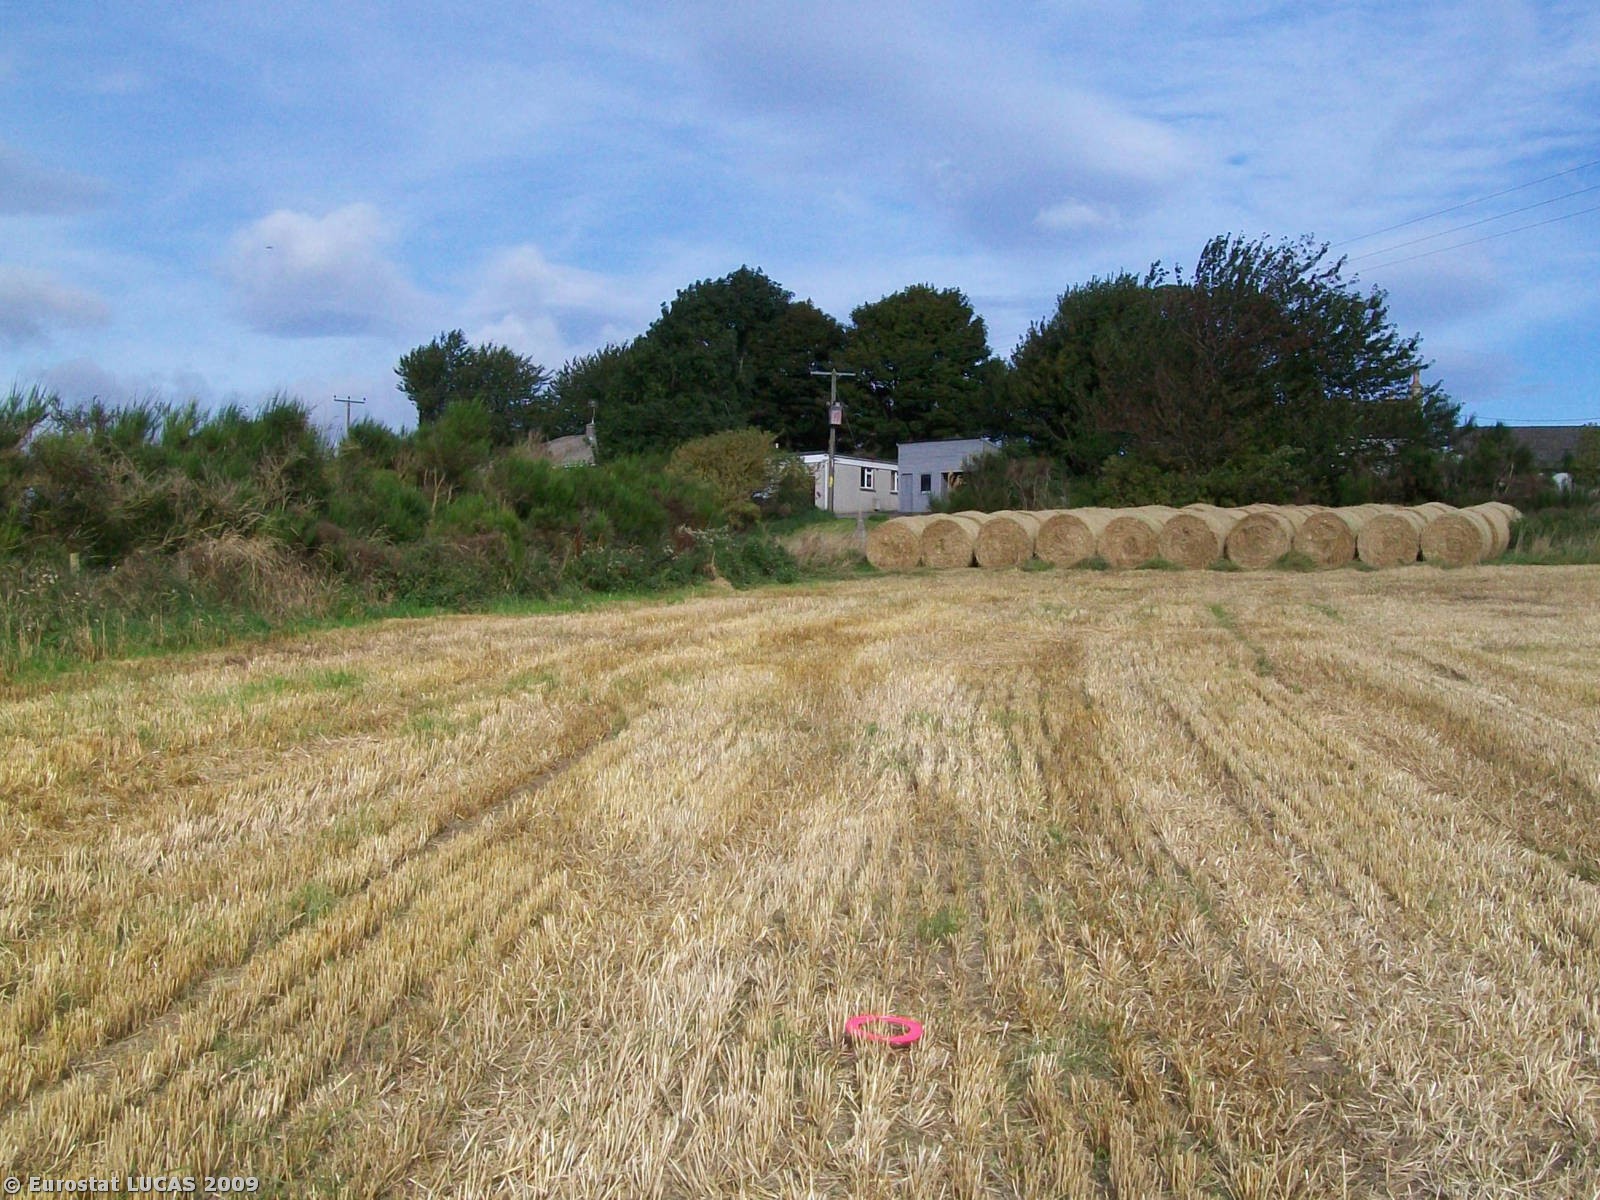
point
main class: Cropland
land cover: Barley
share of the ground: < 10 %
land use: Agriculture (excluding fallow land and kitchen gardens)
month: September
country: GB
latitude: 57.3207
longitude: -2.5250
